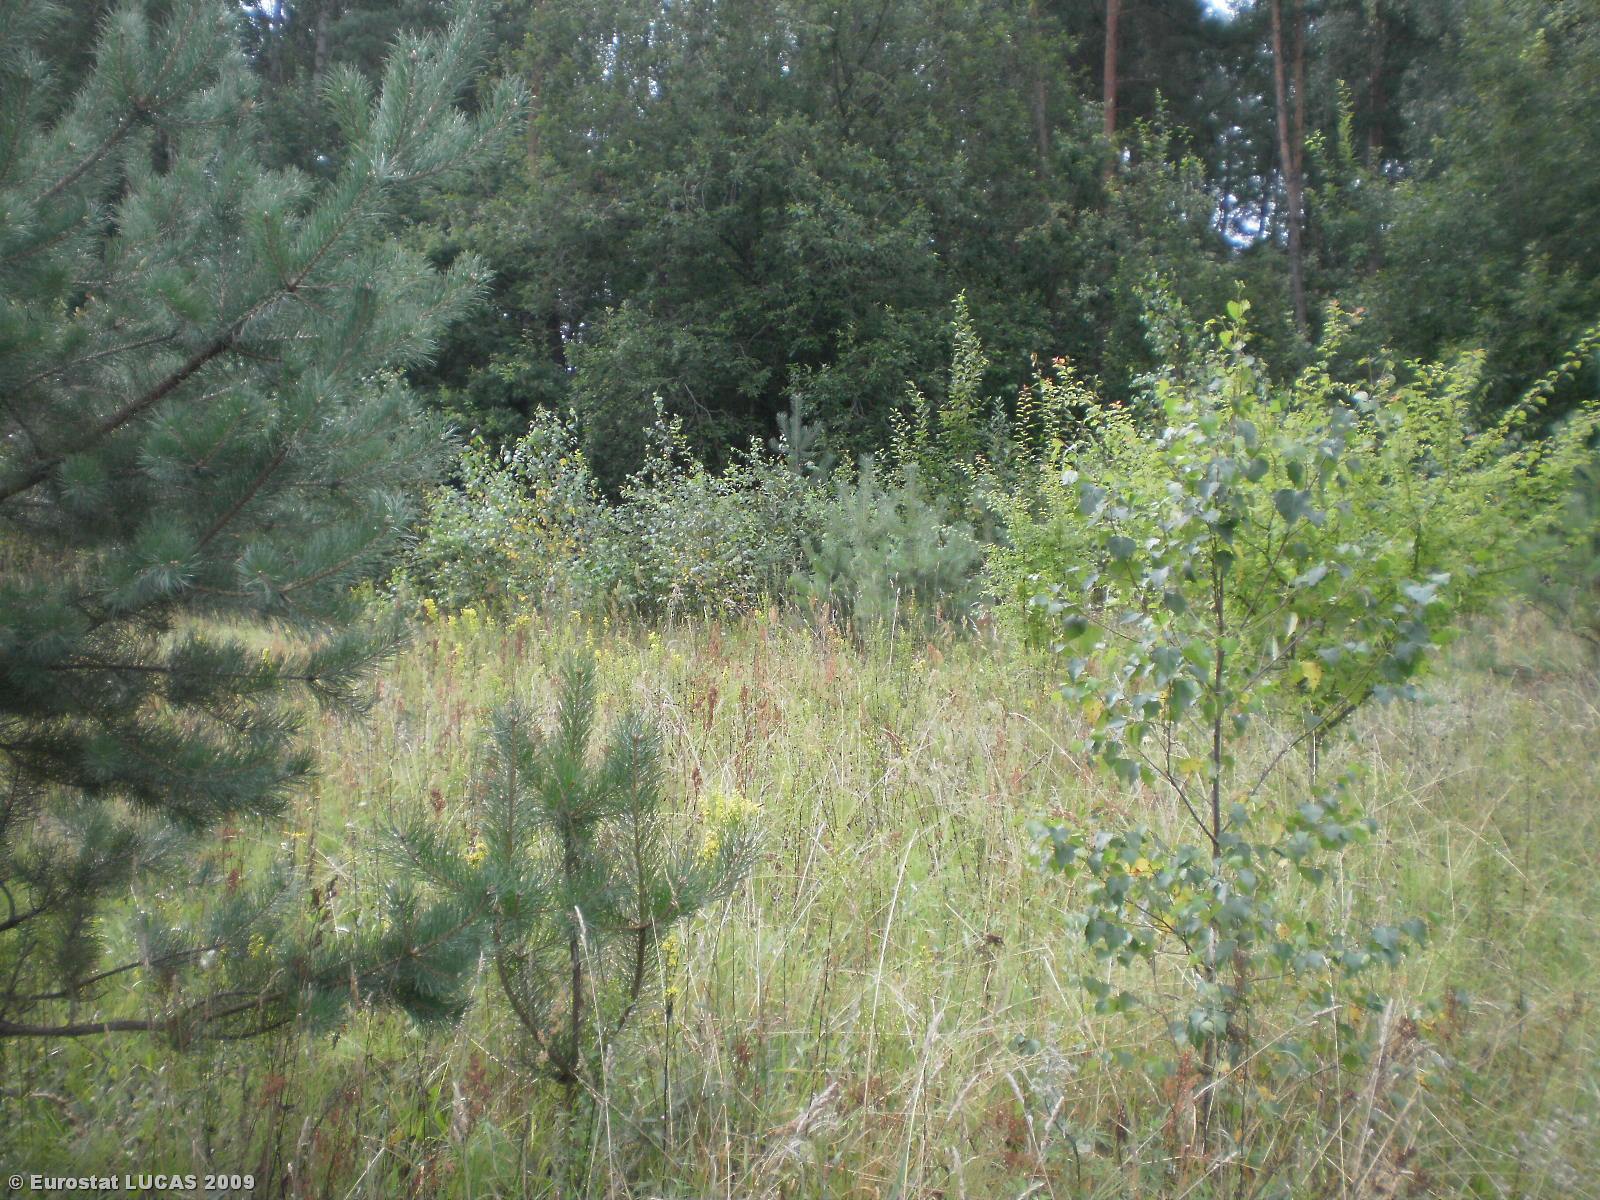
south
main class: Grassland
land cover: Grassland with sparse tree/shrub cover
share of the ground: > 75 %
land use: Forestry
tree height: > 5 m
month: August
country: LT
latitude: 55.2988
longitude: 25.4489
